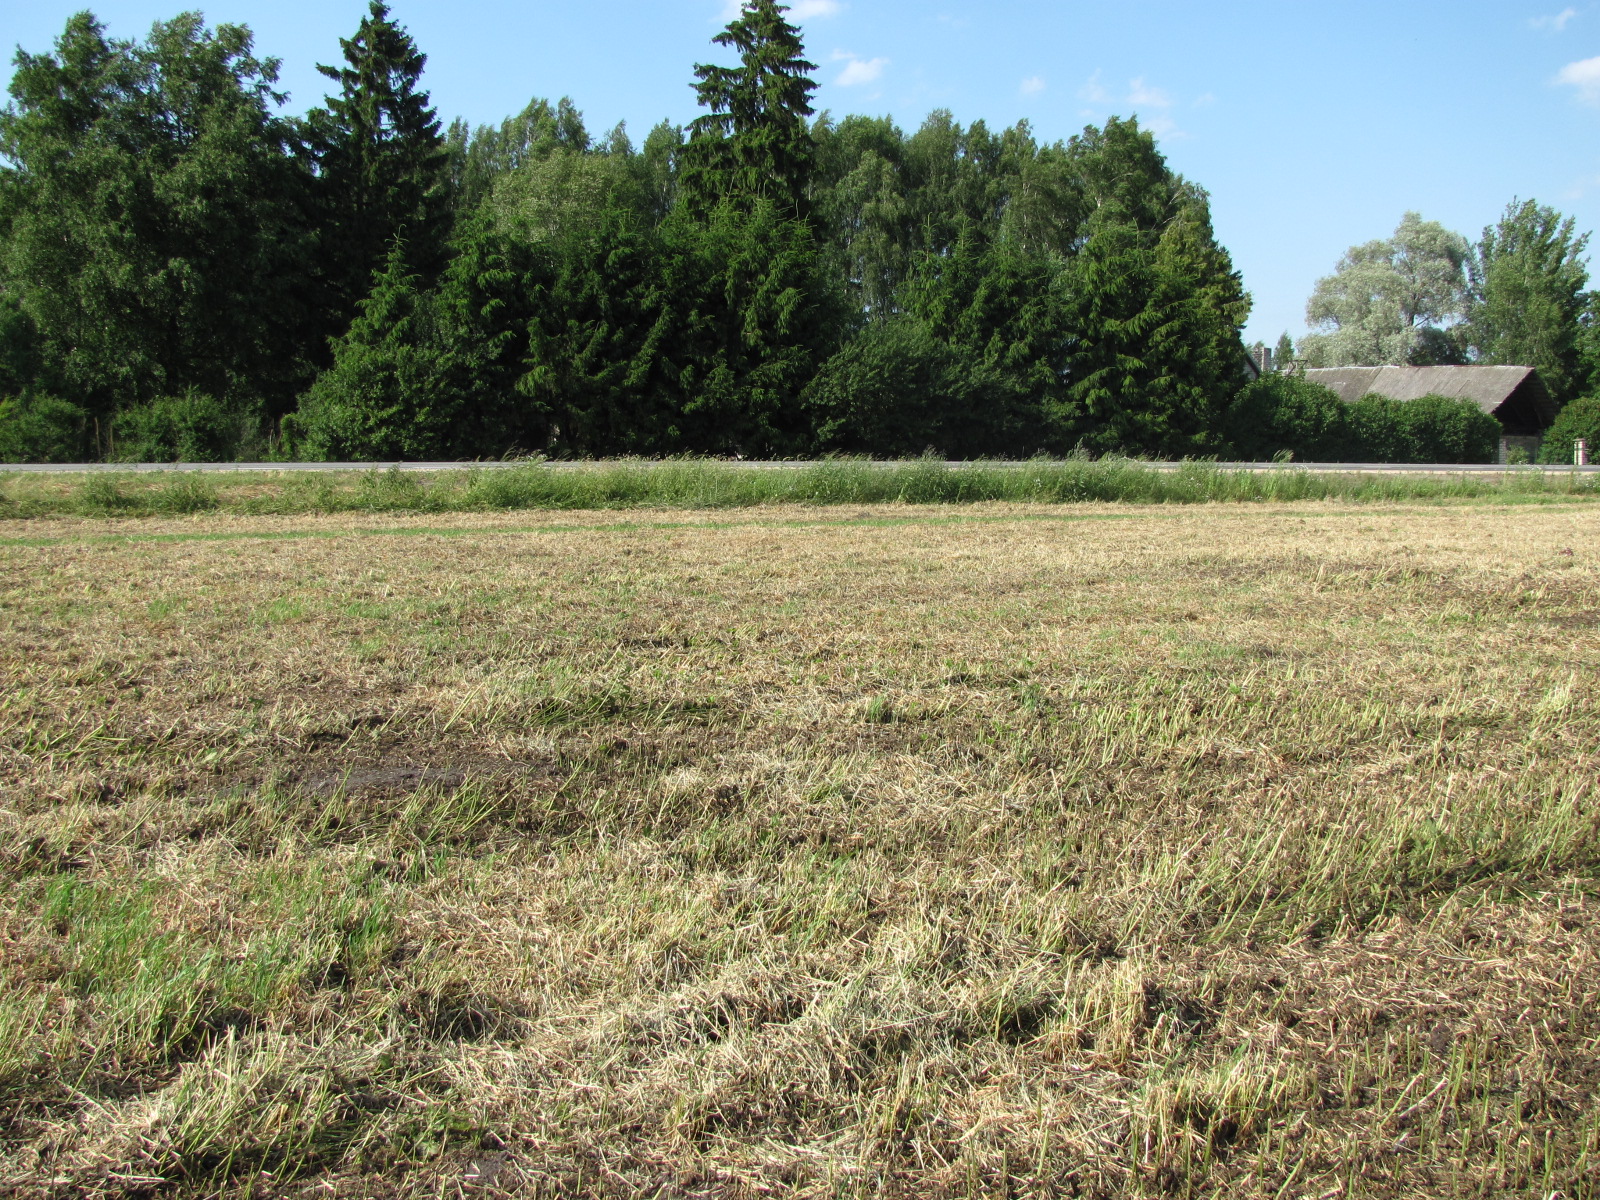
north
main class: Grassland
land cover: Grassland without tree/shrub cover
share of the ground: 10 - 25 %
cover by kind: unconsolidated bare surface 85 %, herbaceous plants 15 %
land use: Agriculture (excluding fallow land and kitchen gardens)
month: July
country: LV
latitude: 56.8939
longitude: 24.0209
